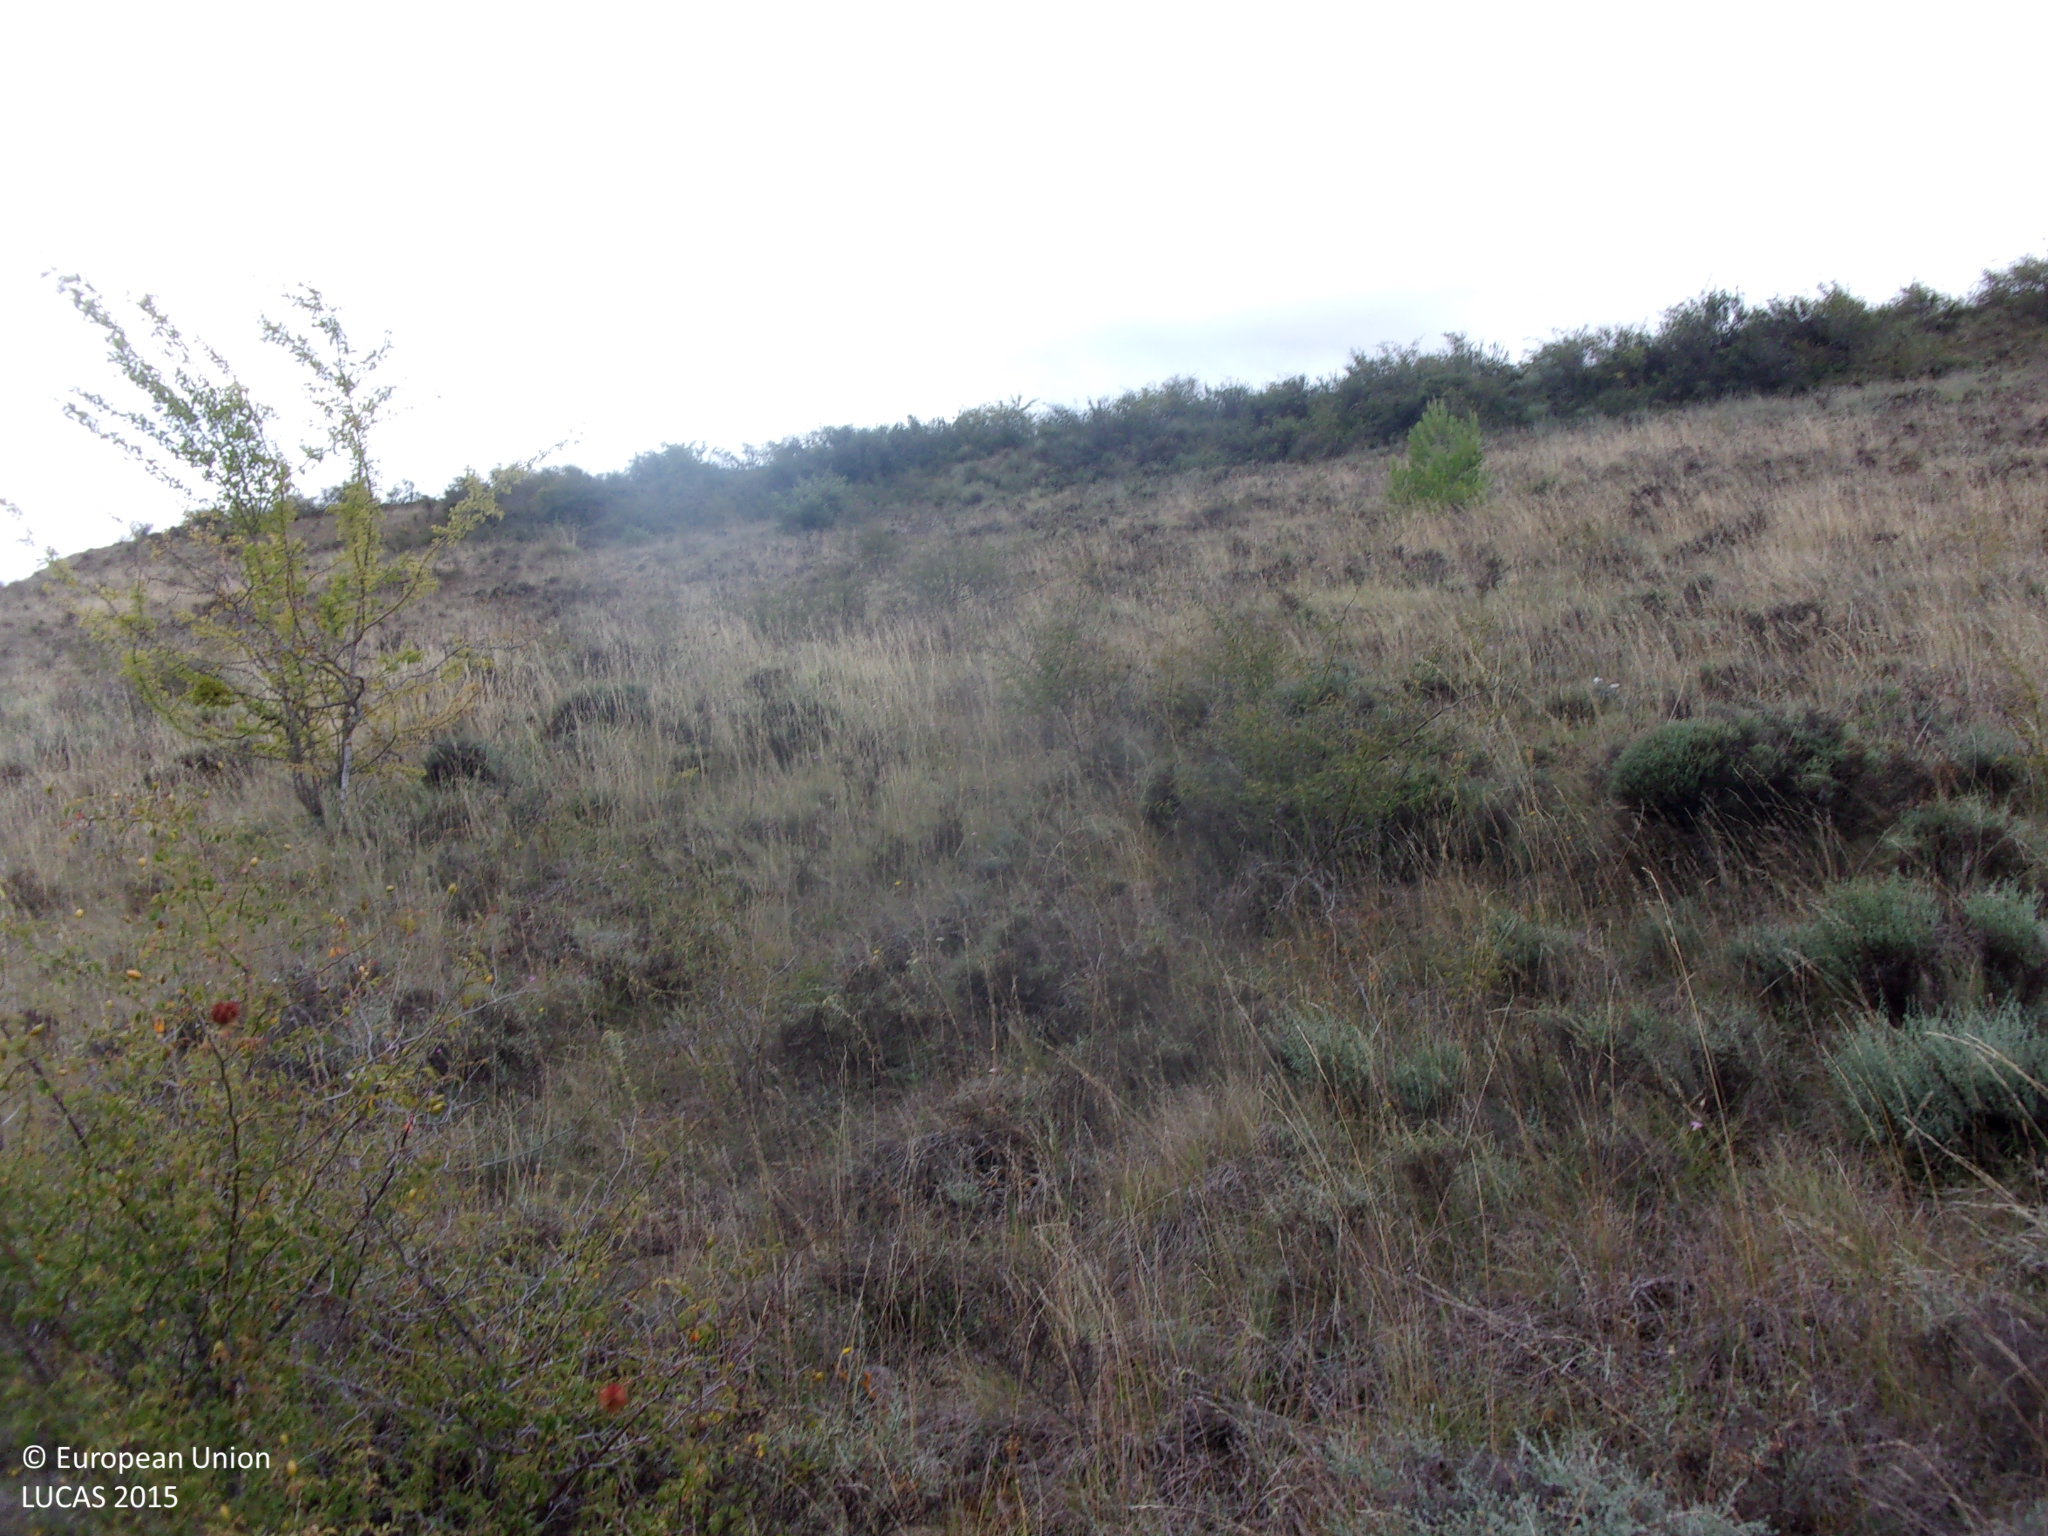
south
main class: Shrubland
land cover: Shrubland without tree cover
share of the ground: 50 - 75 %
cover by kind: shrubs 60 %, herbaceous plants 40 %
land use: Semi-natural and natural areas not in use
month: August
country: ES
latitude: 42.5410
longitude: -1.1982
